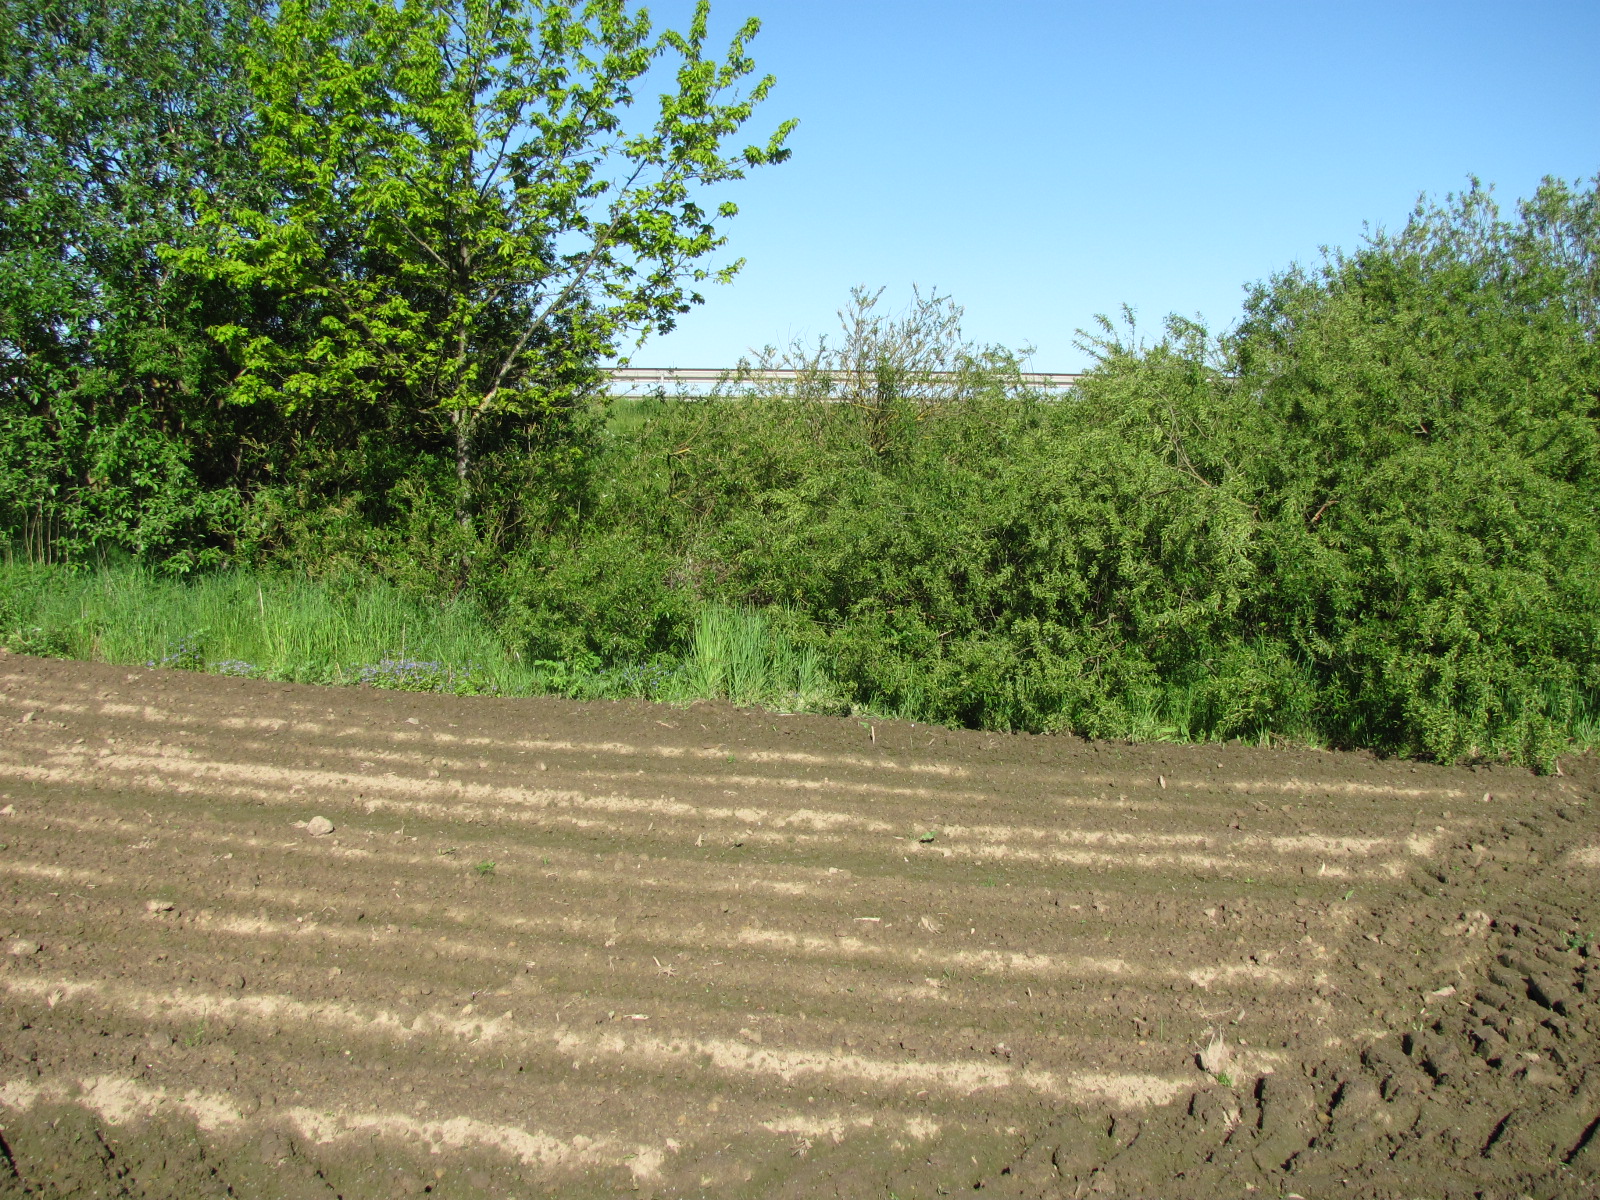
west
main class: Cropland
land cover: Maize
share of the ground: < 10 %
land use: Agriculture (excluding fallow land and kitchen gardens)
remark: Tilled/Sowed
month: May
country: LV
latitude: 56.6162
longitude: 24.2172
